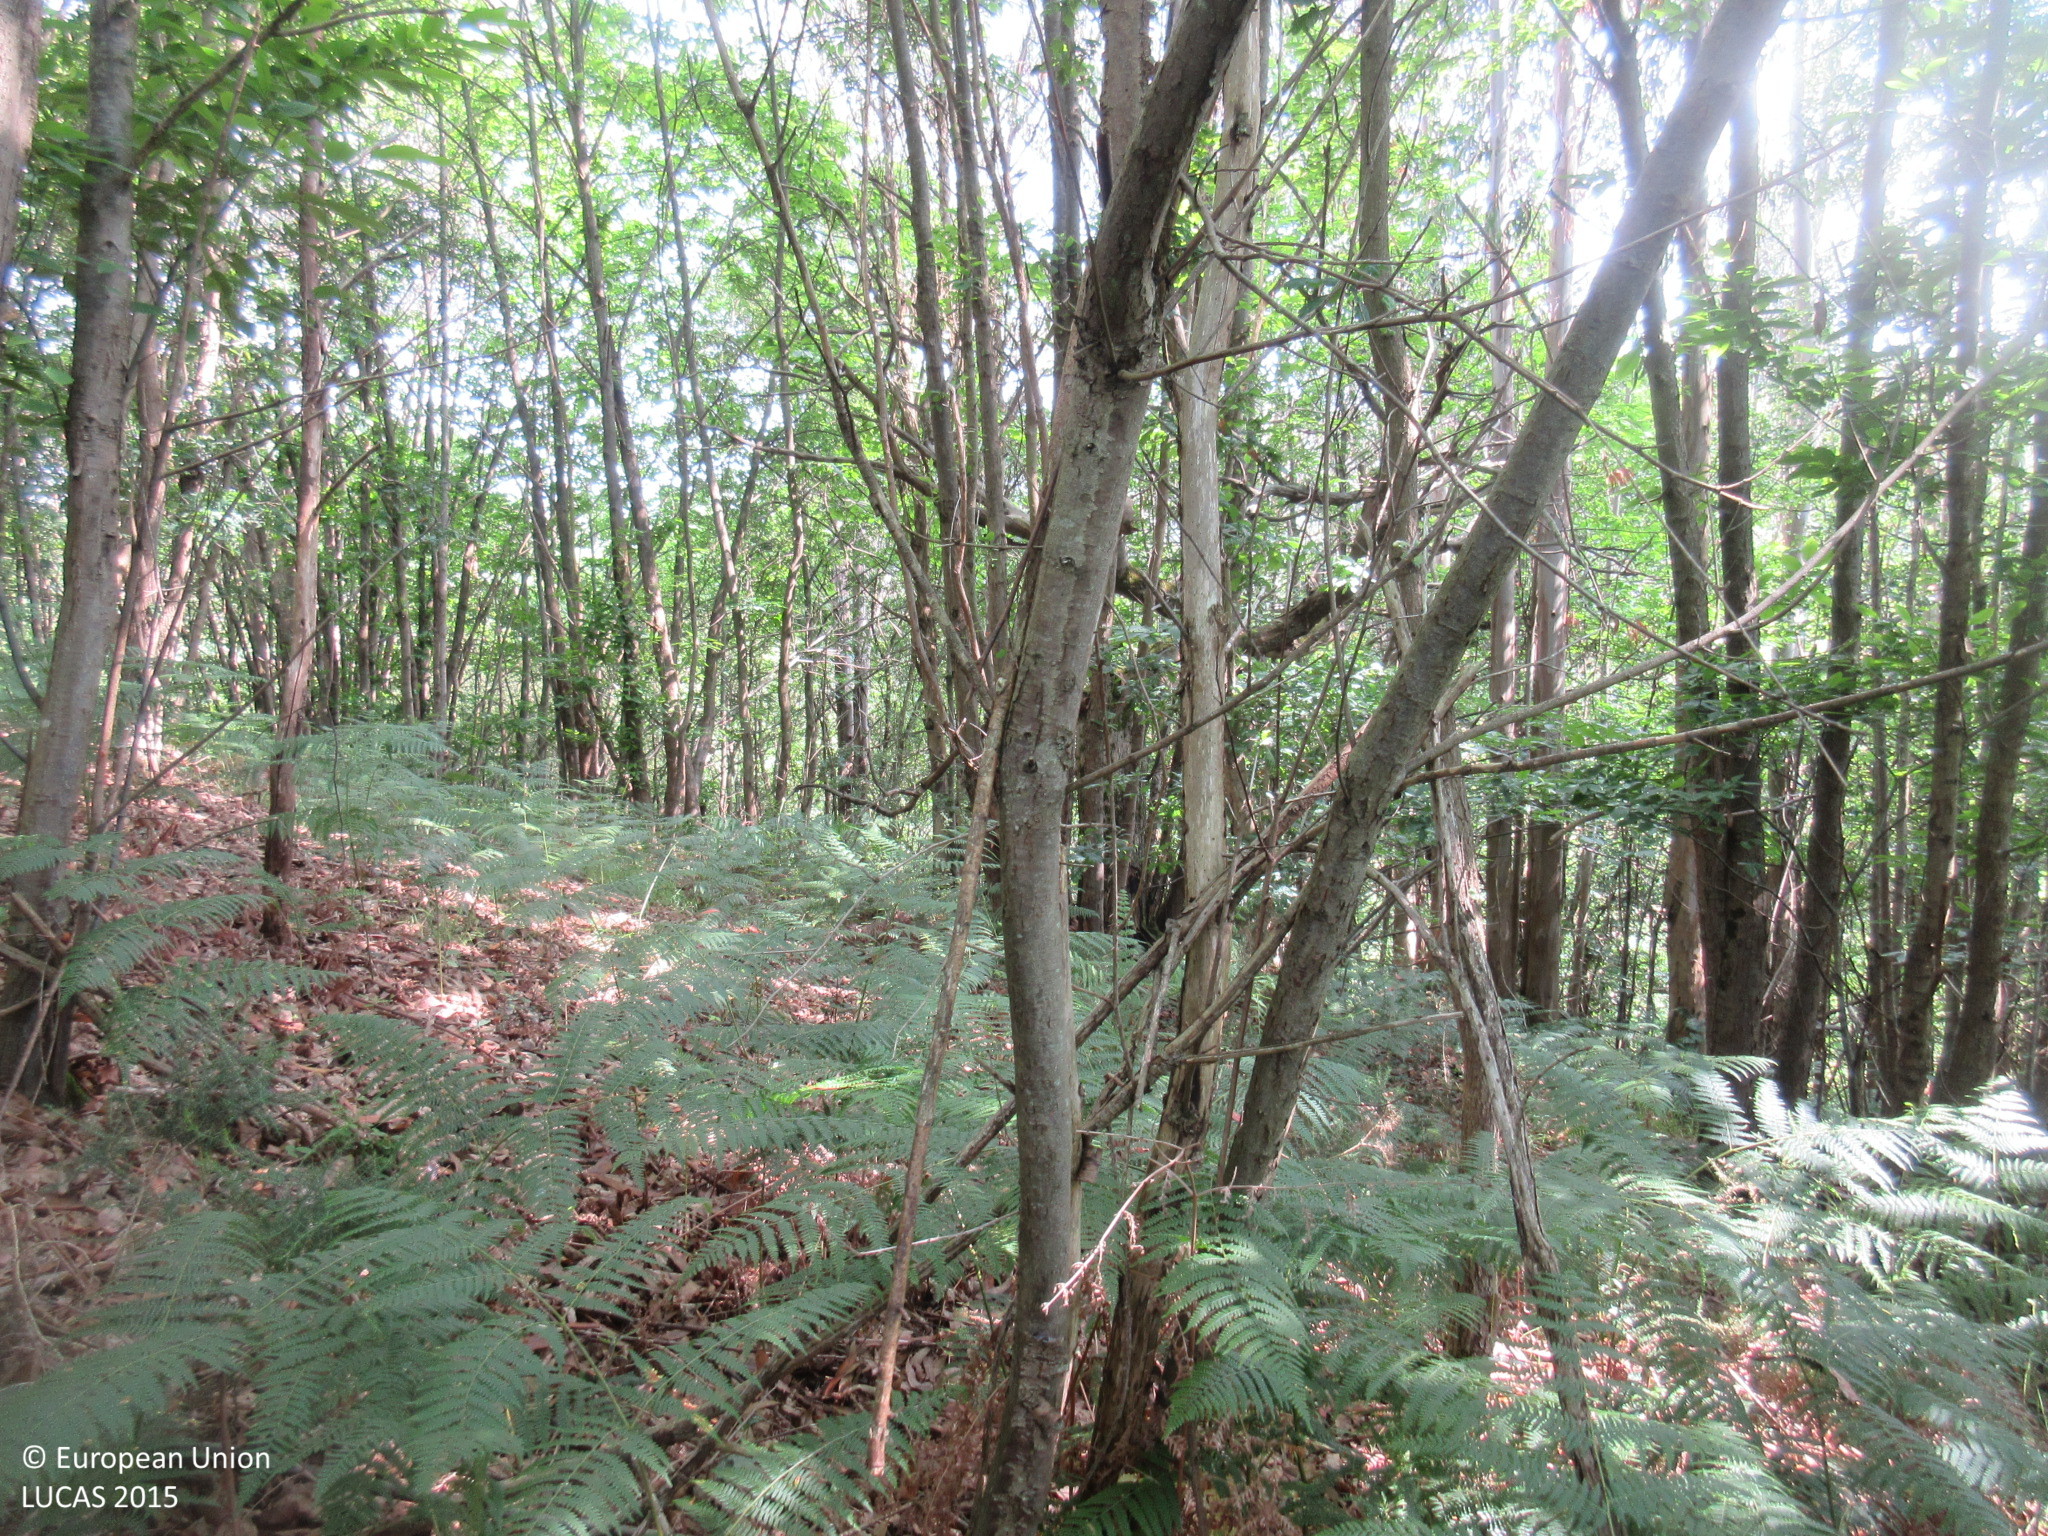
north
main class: Woodland
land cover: Broadleaved woodland
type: thermophilous deciduous forest
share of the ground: > 75 %
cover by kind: broadleaved forest trees 95 %, shrubs 5 %
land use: Forestry
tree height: > 5 m
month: June
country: ES
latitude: 43.4175
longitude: -5.9615
